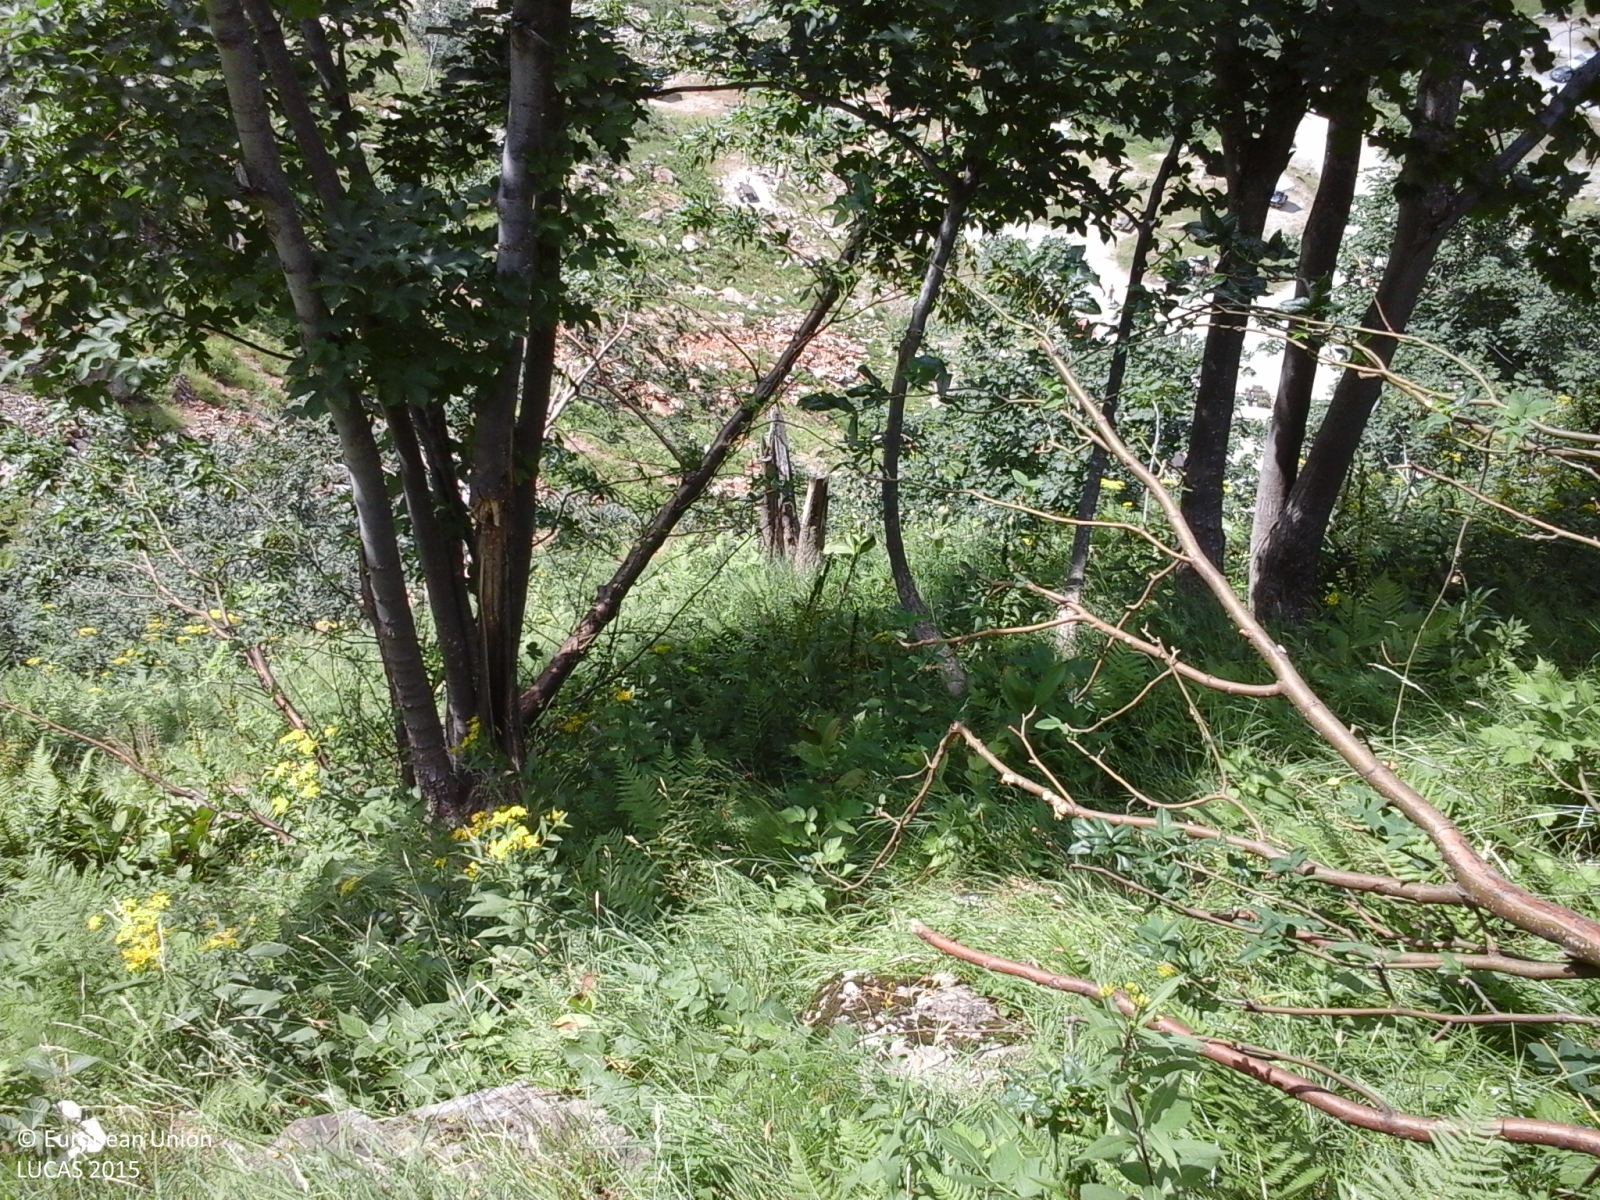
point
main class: Woodland
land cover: Broadleaved woodland
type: mountainous beech forest
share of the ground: 50 - 75 %
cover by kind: broadleaved forest trees 60 %, shrubs 20 %, consolidated bare surface 20 %
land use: Semi-natural and natural areas not in use
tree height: > 5 m
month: July
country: IT
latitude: 44.1722
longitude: 7.3418
